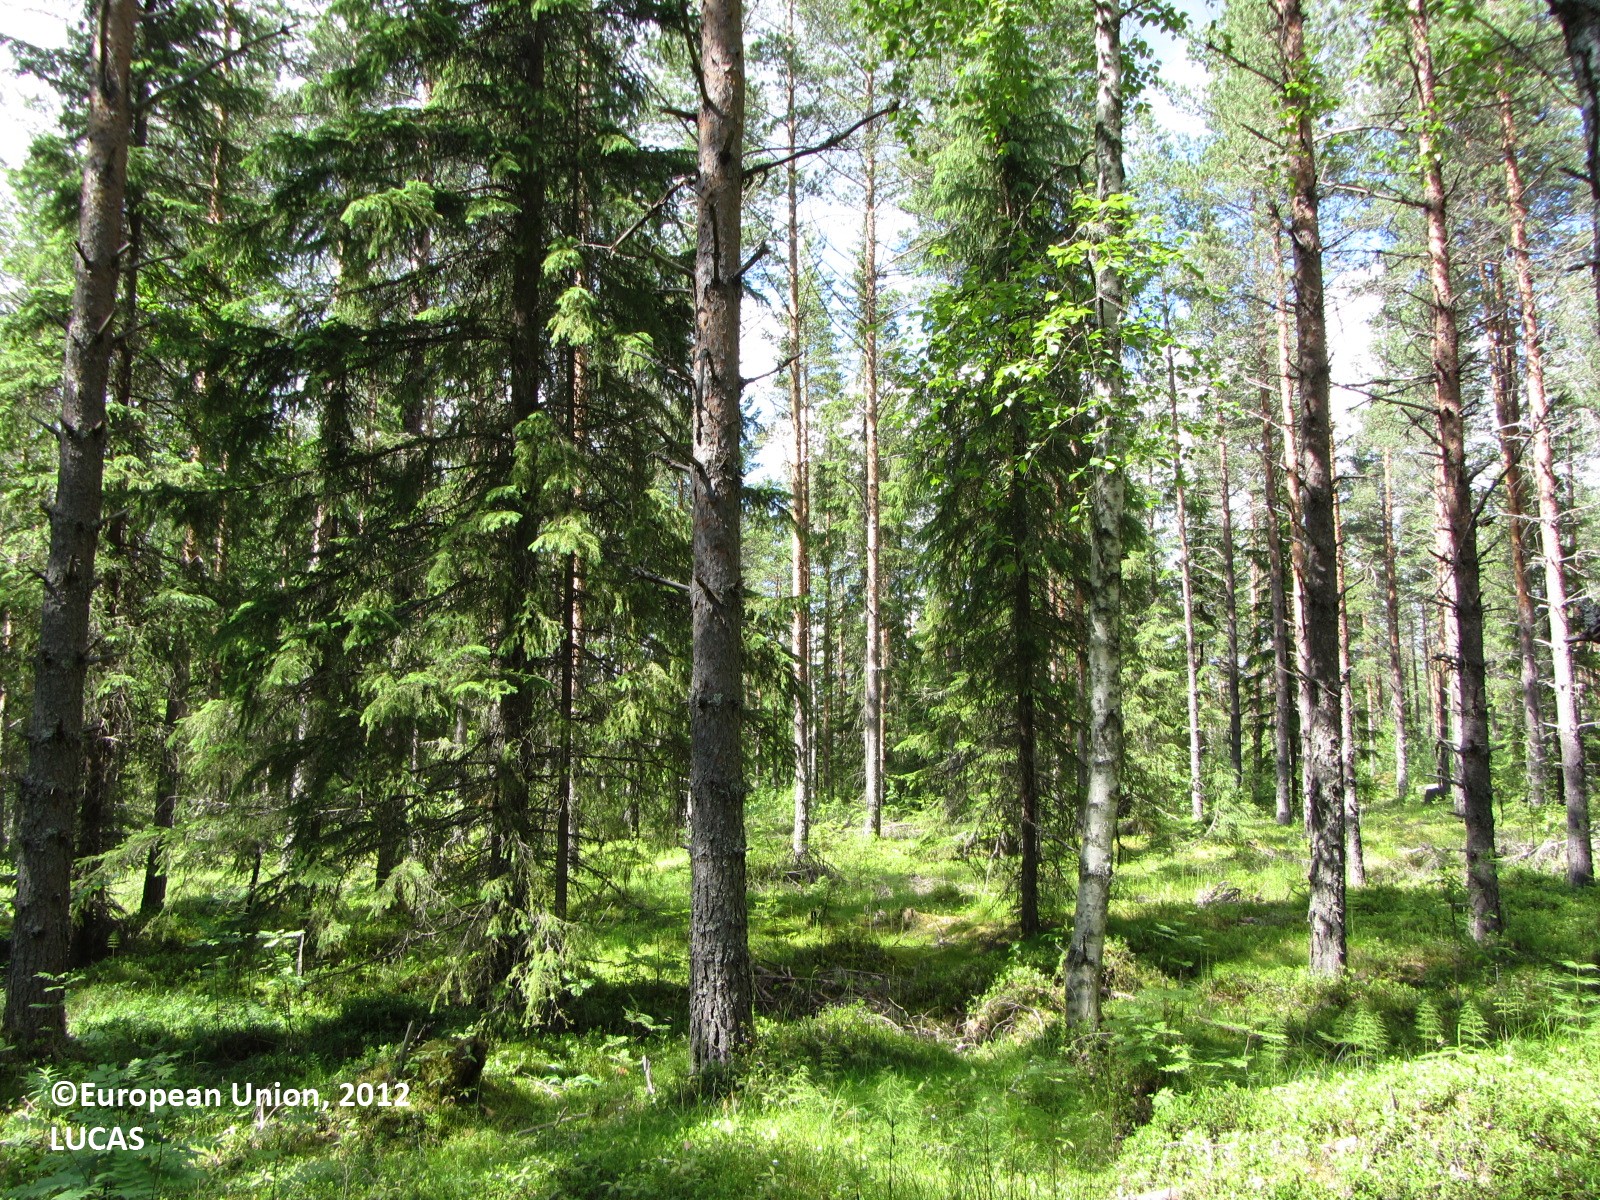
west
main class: Woodland
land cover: Other mixed woodland
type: boreal forest
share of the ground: > 75 %
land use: Forestry
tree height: > 5 m
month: July
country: FI
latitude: 62.8335
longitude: 25.5200
